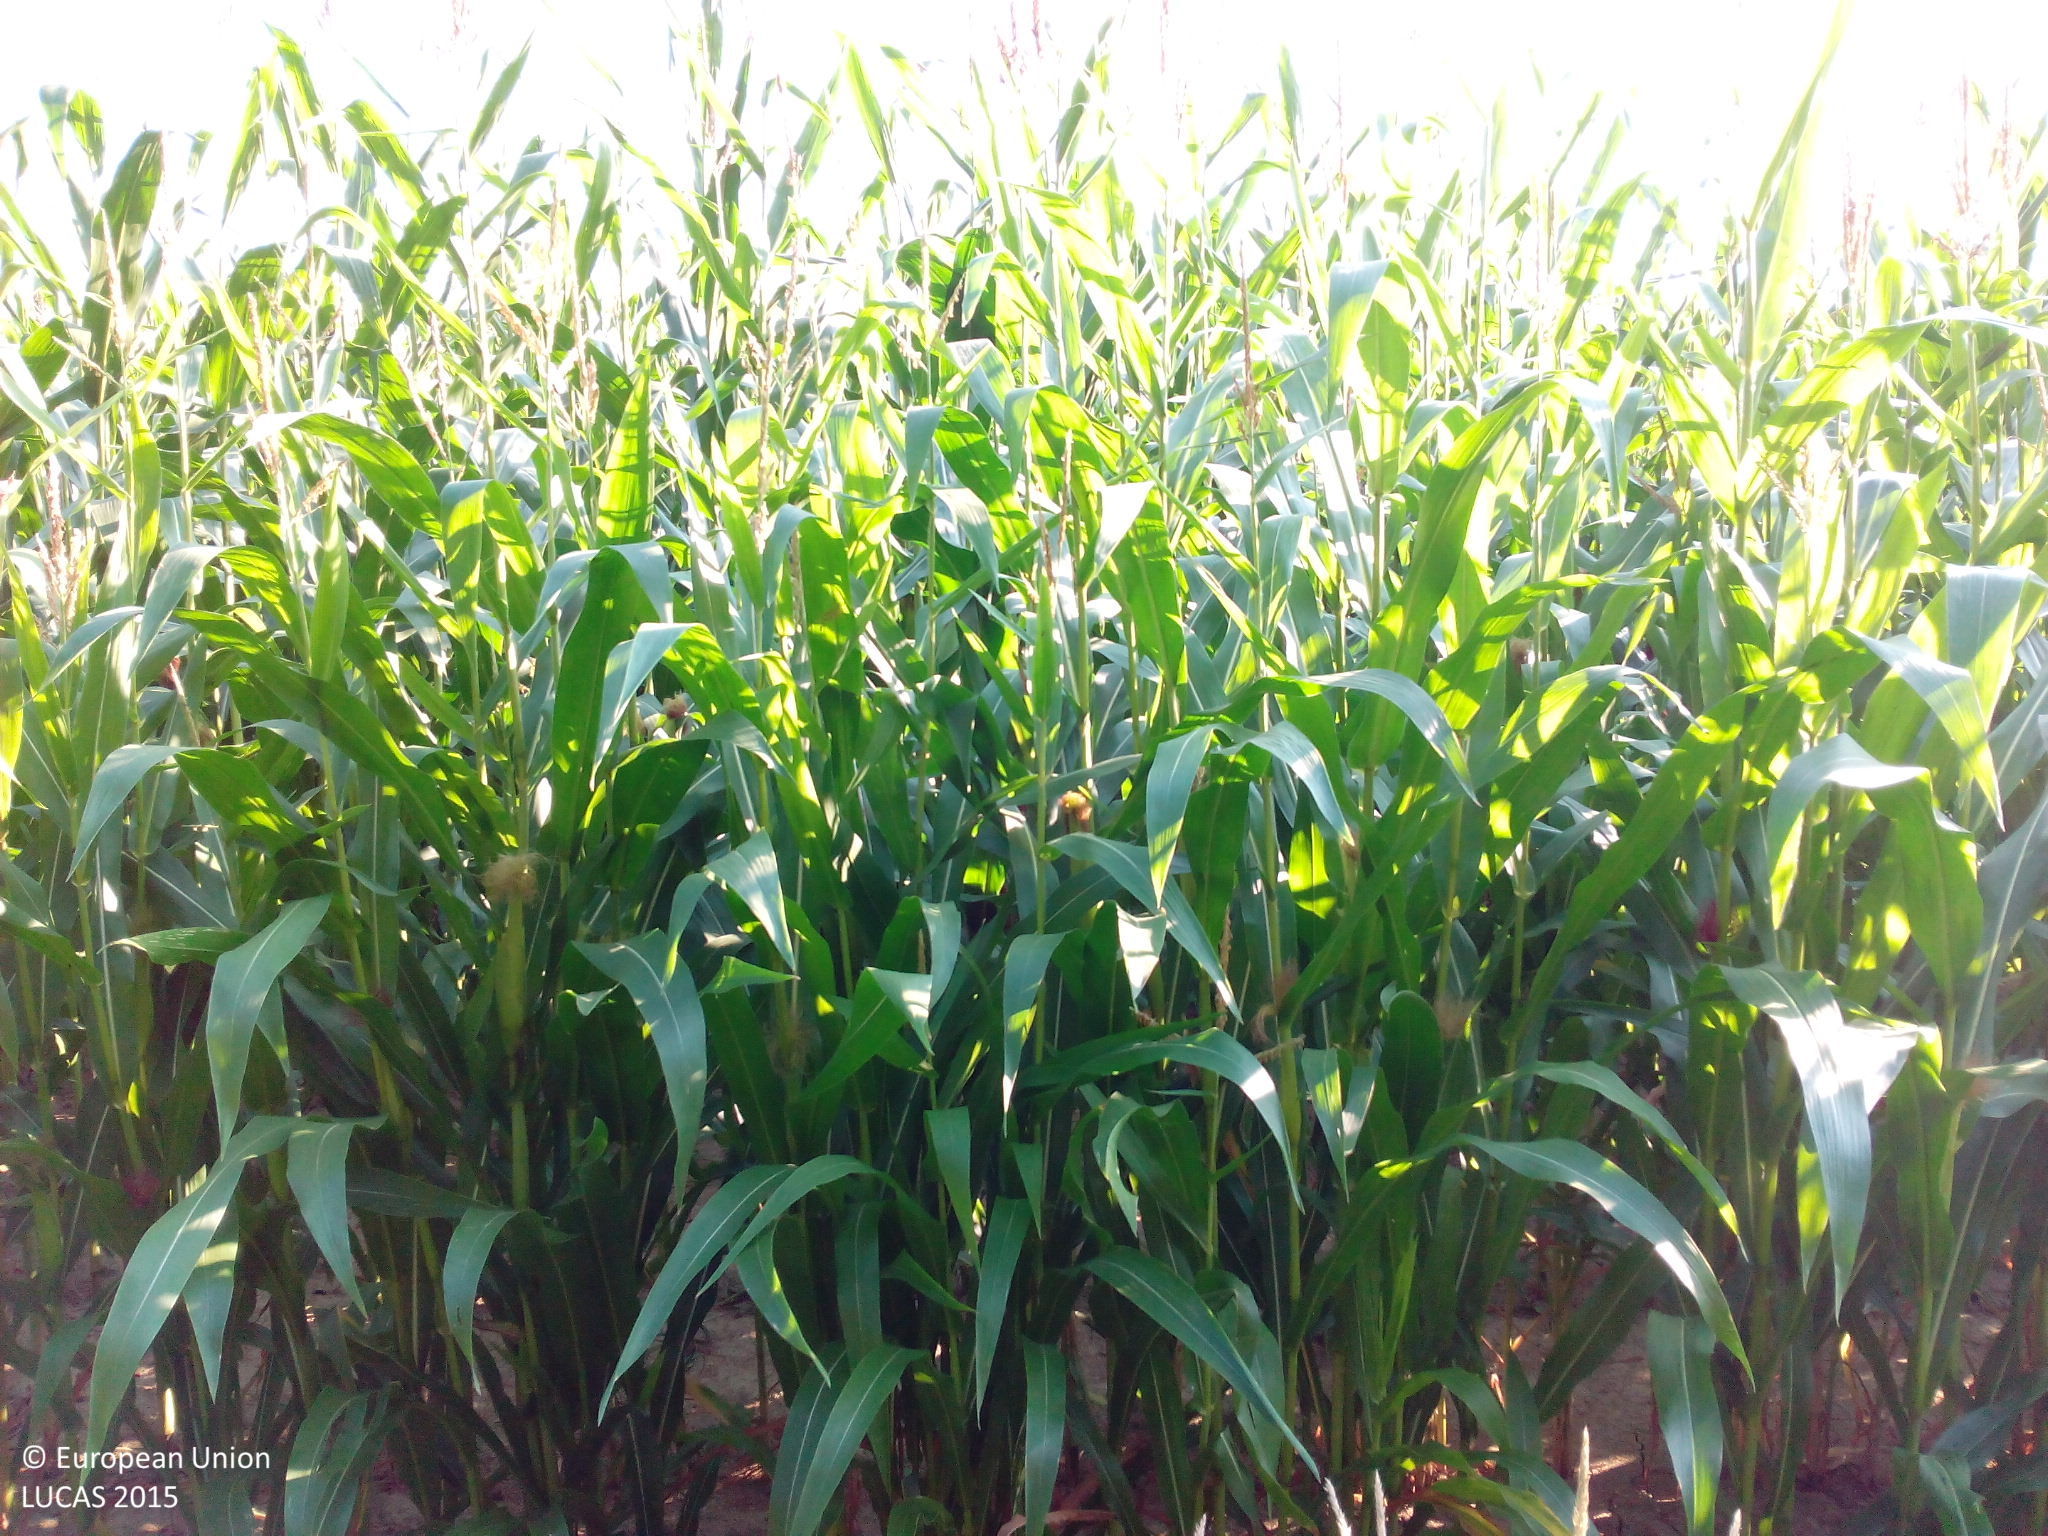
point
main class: Cropland
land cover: Maize
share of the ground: > 75 %
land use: Agriculture (excluding fallow land and kitchen gardens)
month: August
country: DE
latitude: 48.7441
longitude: 10.5301
